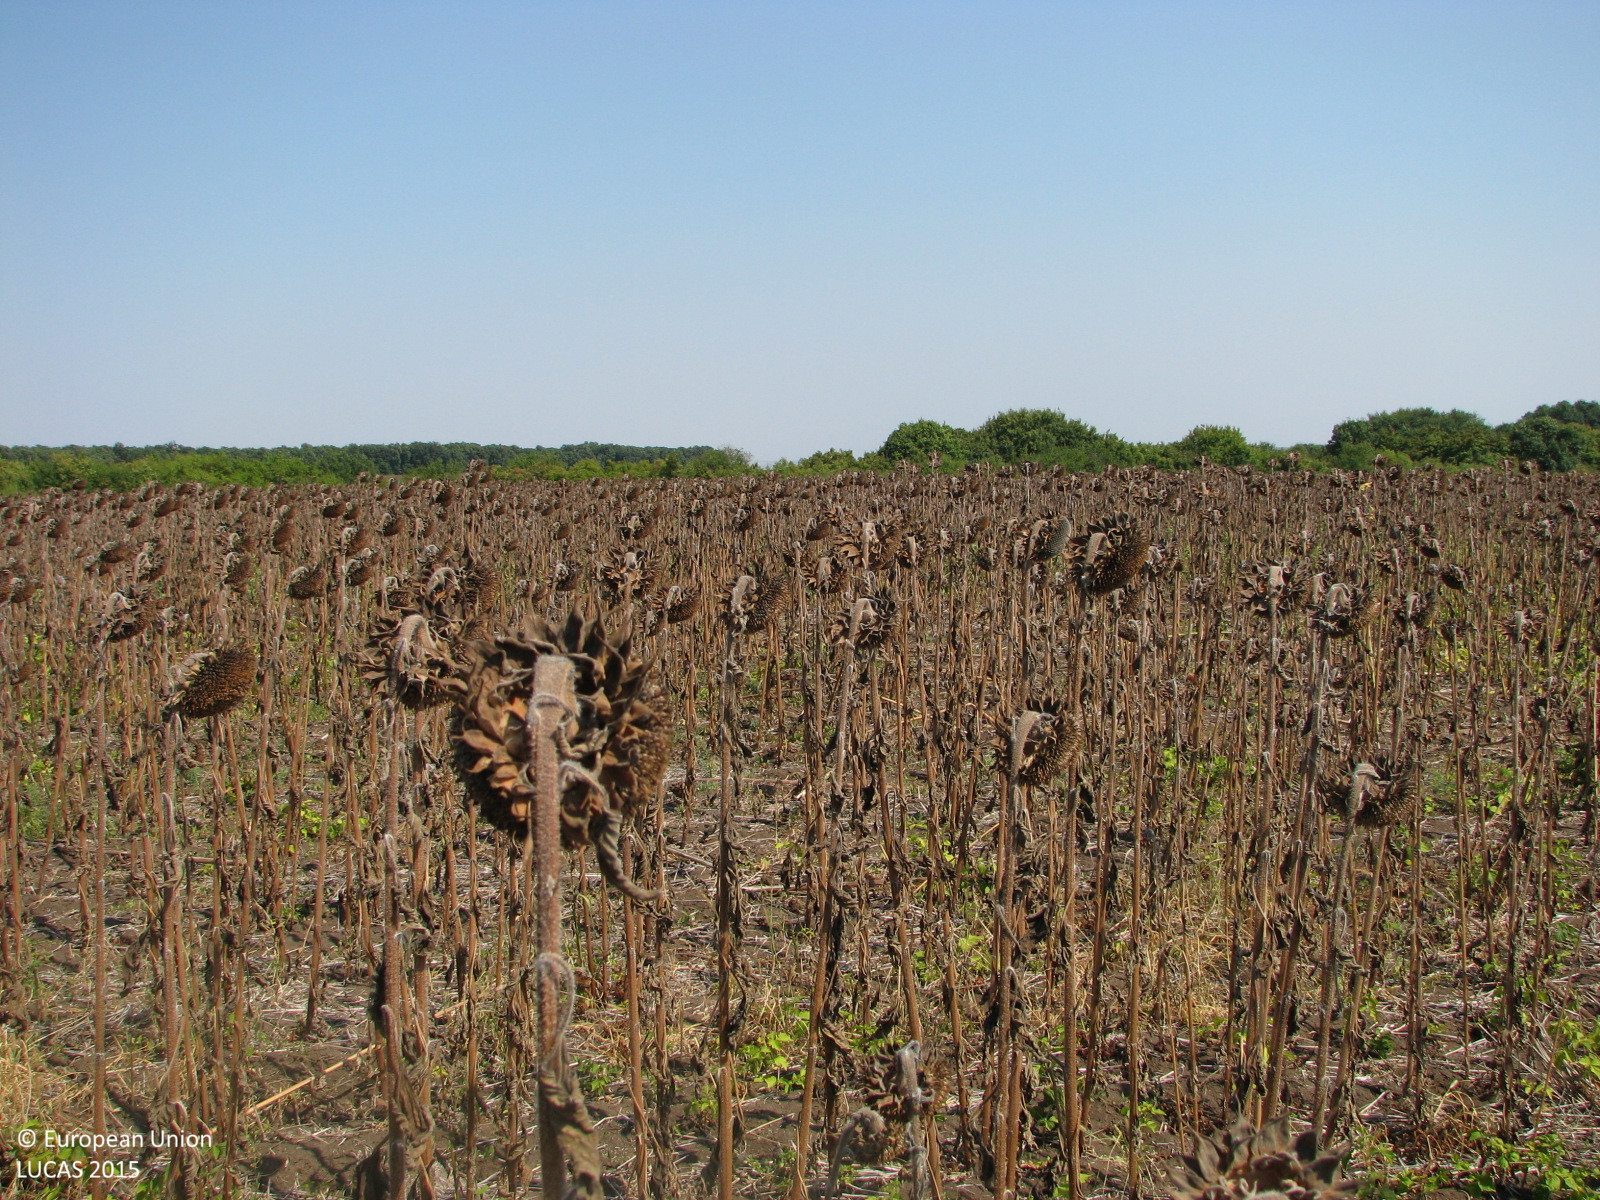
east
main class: Cropland
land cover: Sunflower
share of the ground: 50 - 75 %
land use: Agriculture (excluding fallow land and kitchen gardens)
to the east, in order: Sunflower; Grass margins; Broadleaved woodland; Grass margins; Tracks; Sunflower
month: September
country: BG
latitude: 42.4020
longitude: 26.7792
